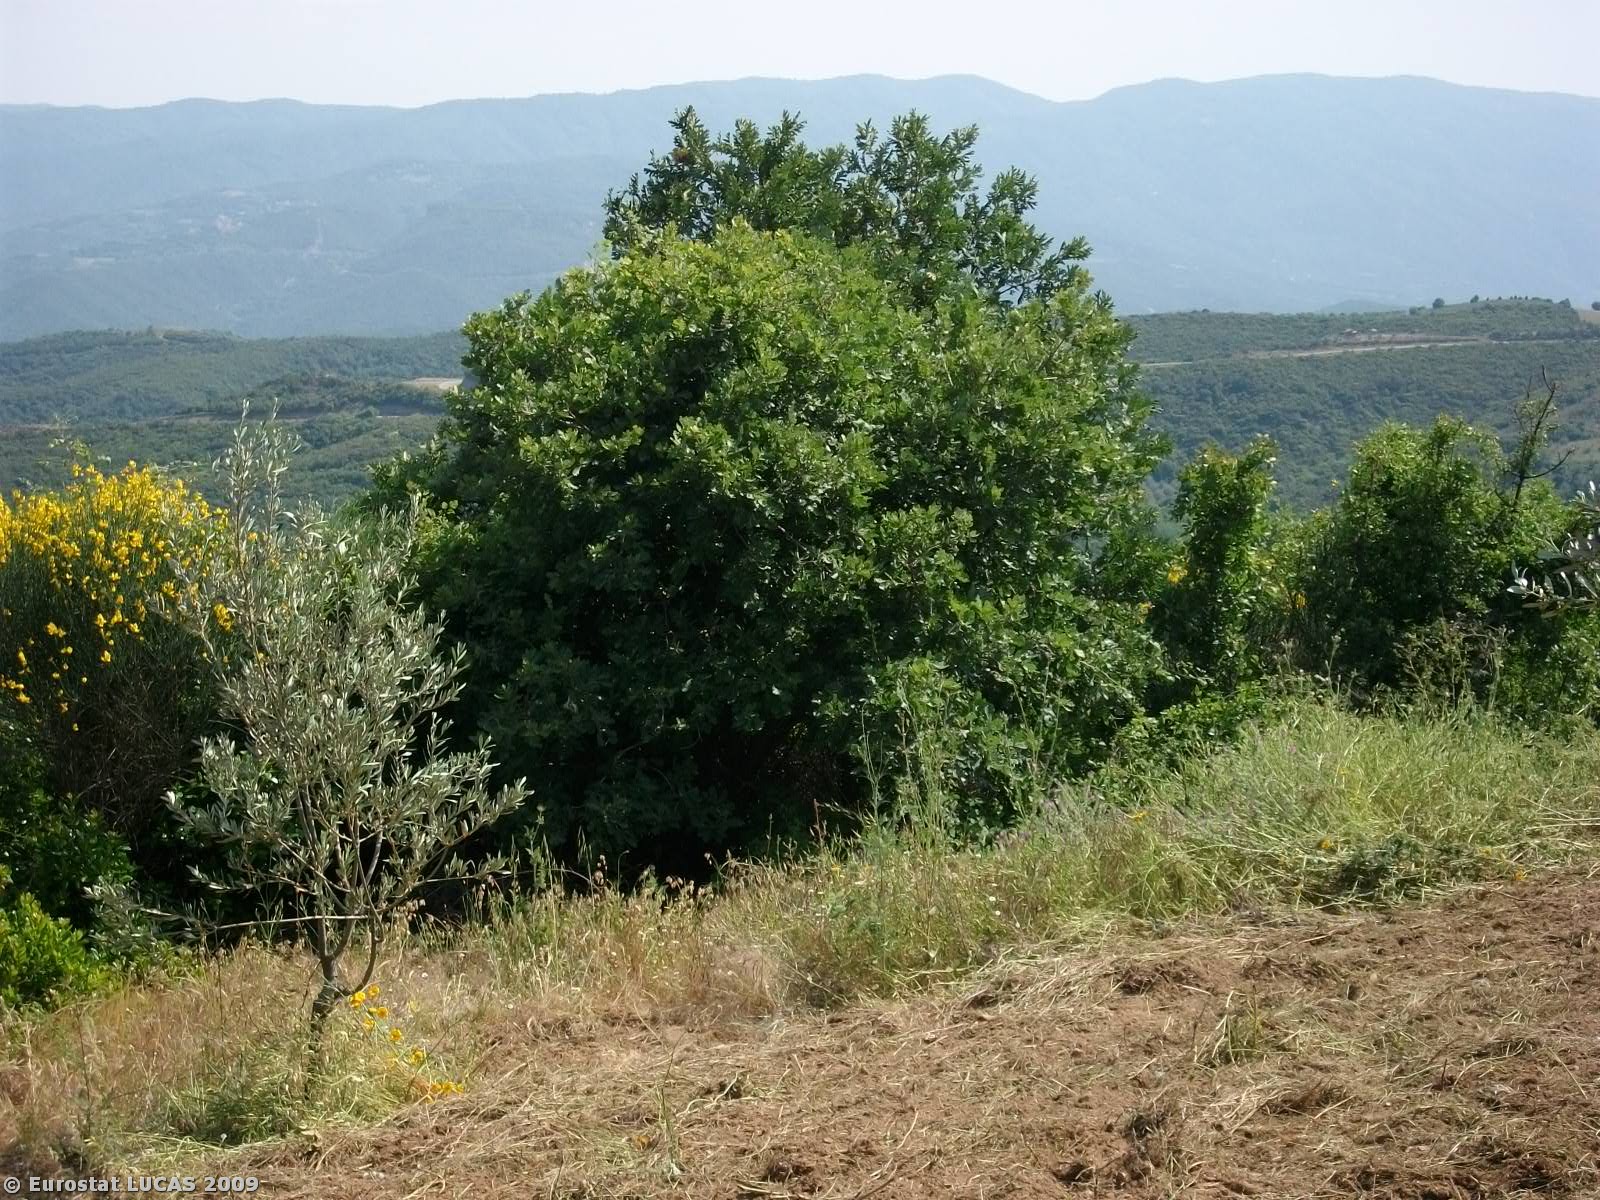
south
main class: Woodland
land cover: Broadleaved woodland
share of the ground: > 75 %
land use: Forestry
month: May
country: GR
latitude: 39.7516
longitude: 22.8217
